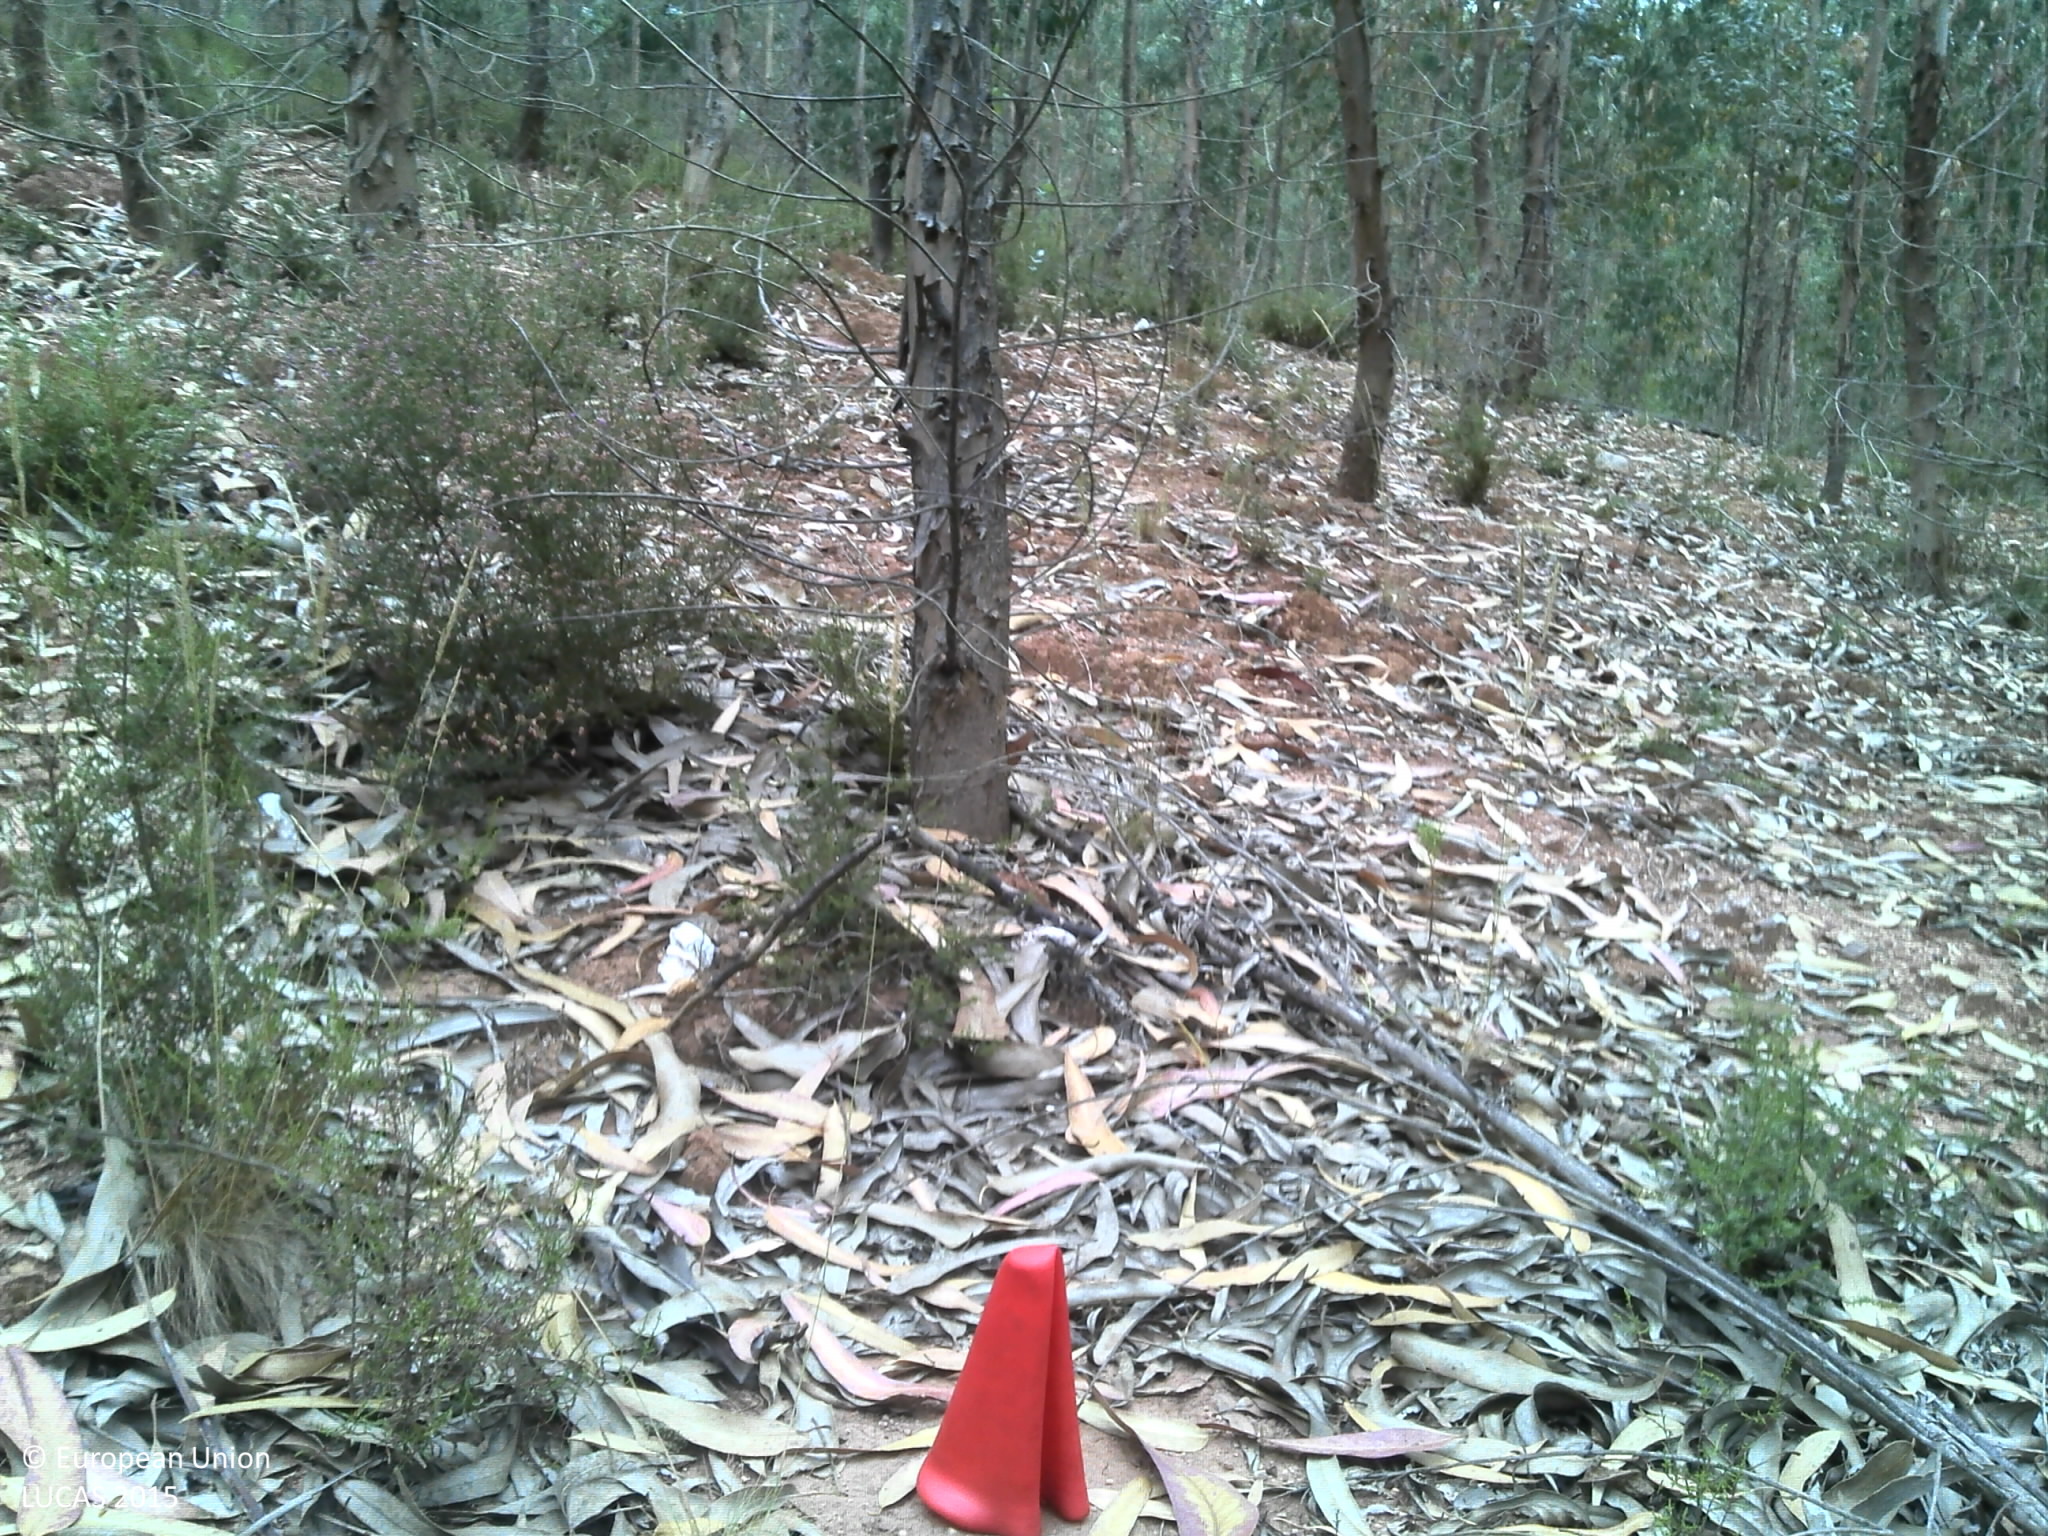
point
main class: Woodland
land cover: Broadleaved woodland
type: exotic forest
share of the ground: 50 - 75 %
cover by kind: broadleaved forest trees 60 %, unconsolidated bare surface 30 %, shrubs 10 %
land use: Forestry
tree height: > 5 m
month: June
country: PT
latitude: 40.4171
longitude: -8.3886
